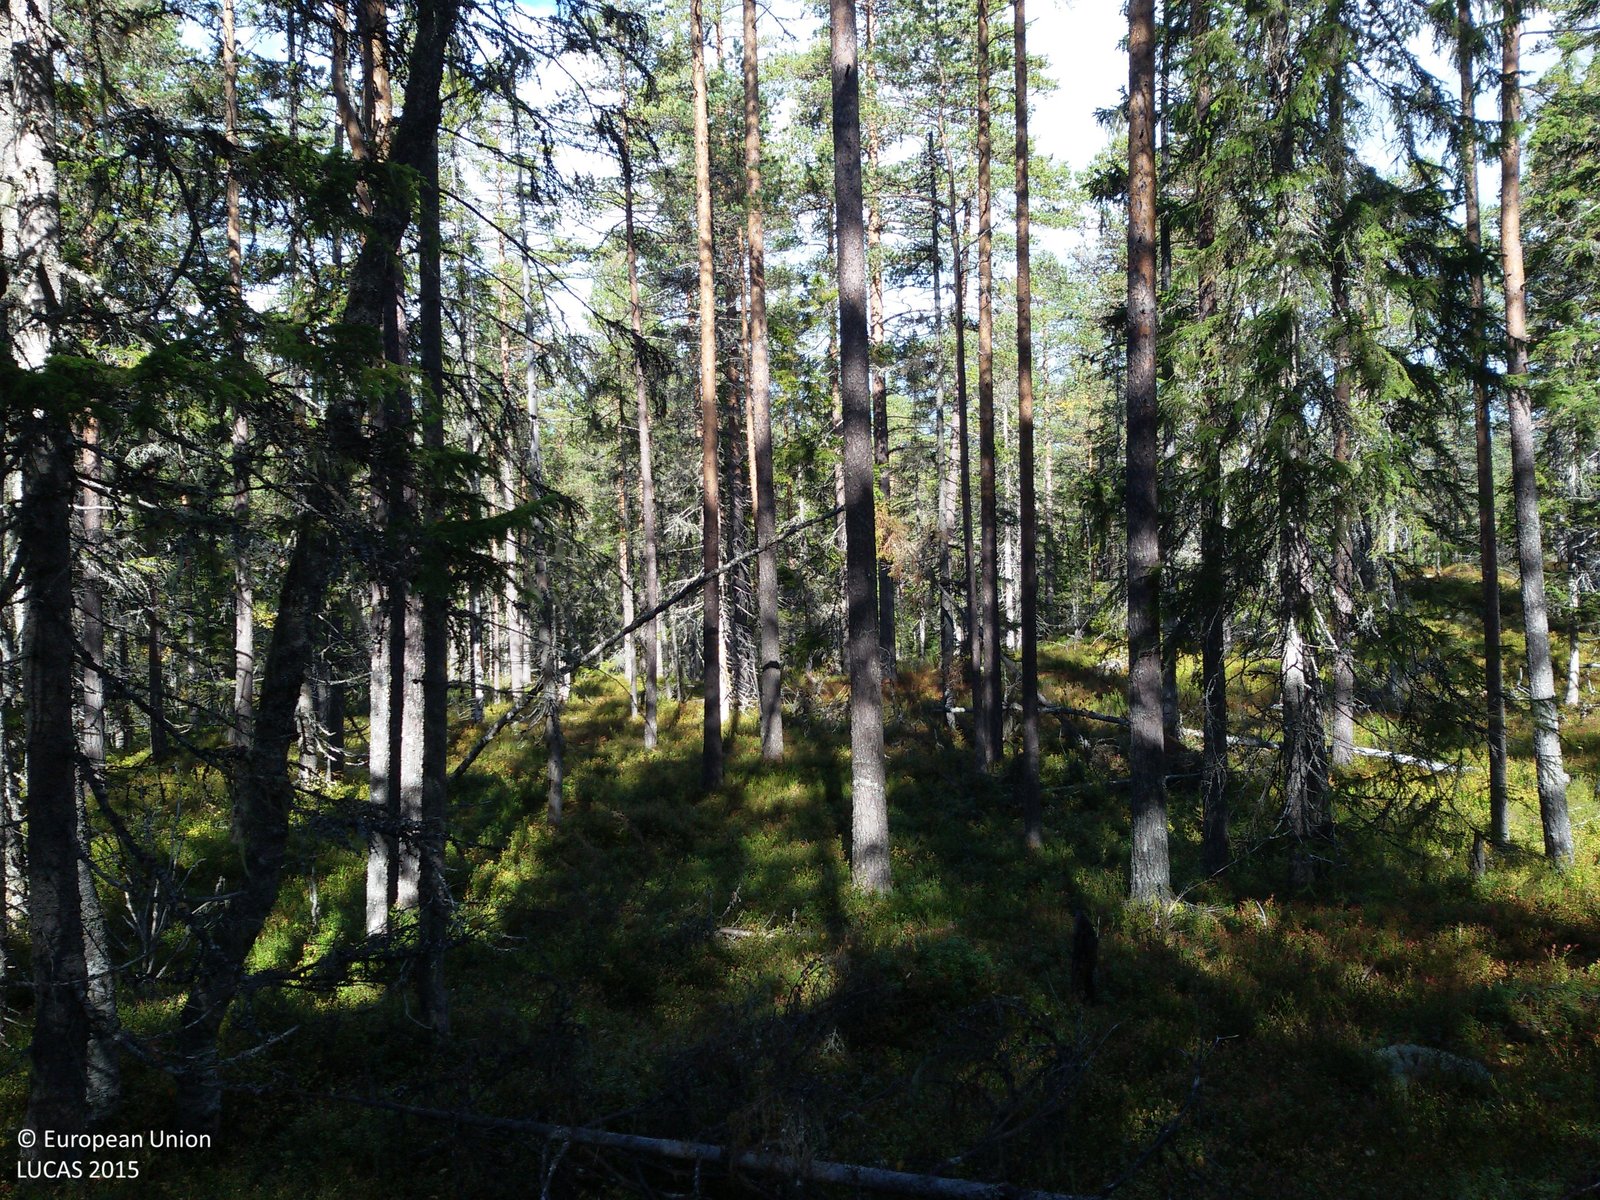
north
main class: Woodland
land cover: Other coniferous woodland
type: boreal forest
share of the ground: 50 - 75 %
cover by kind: coniferous forest trees 60 %, shrubs 30 %, lichens and mosses 10 %
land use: Forestry
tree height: > 5 m
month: September
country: SE
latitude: 60.7373
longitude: 14.5906
